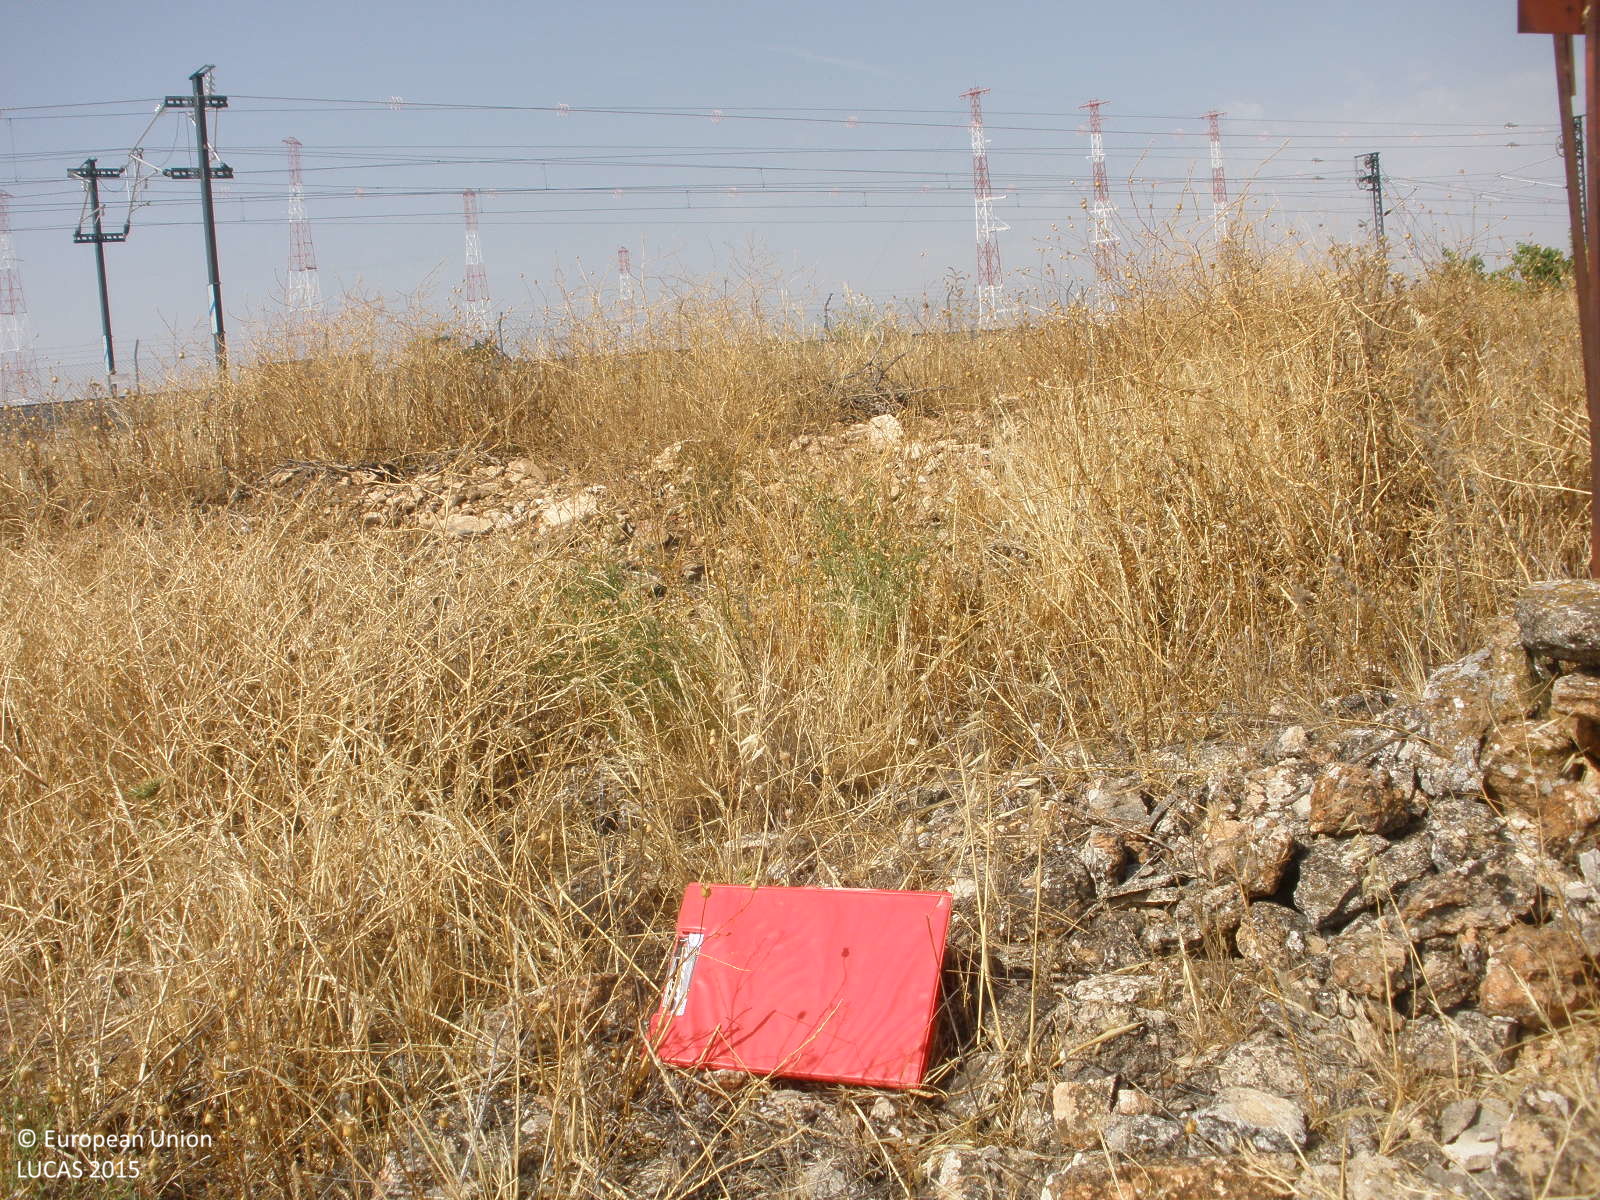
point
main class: Grassland
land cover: Grassland without tree/shrub cover
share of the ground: > 75 %
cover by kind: herbaceous plants 75 %, consolidated bare surface 25 %
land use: Abandoned areas
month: July
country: ES
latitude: 39.9439
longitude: -3.4286
